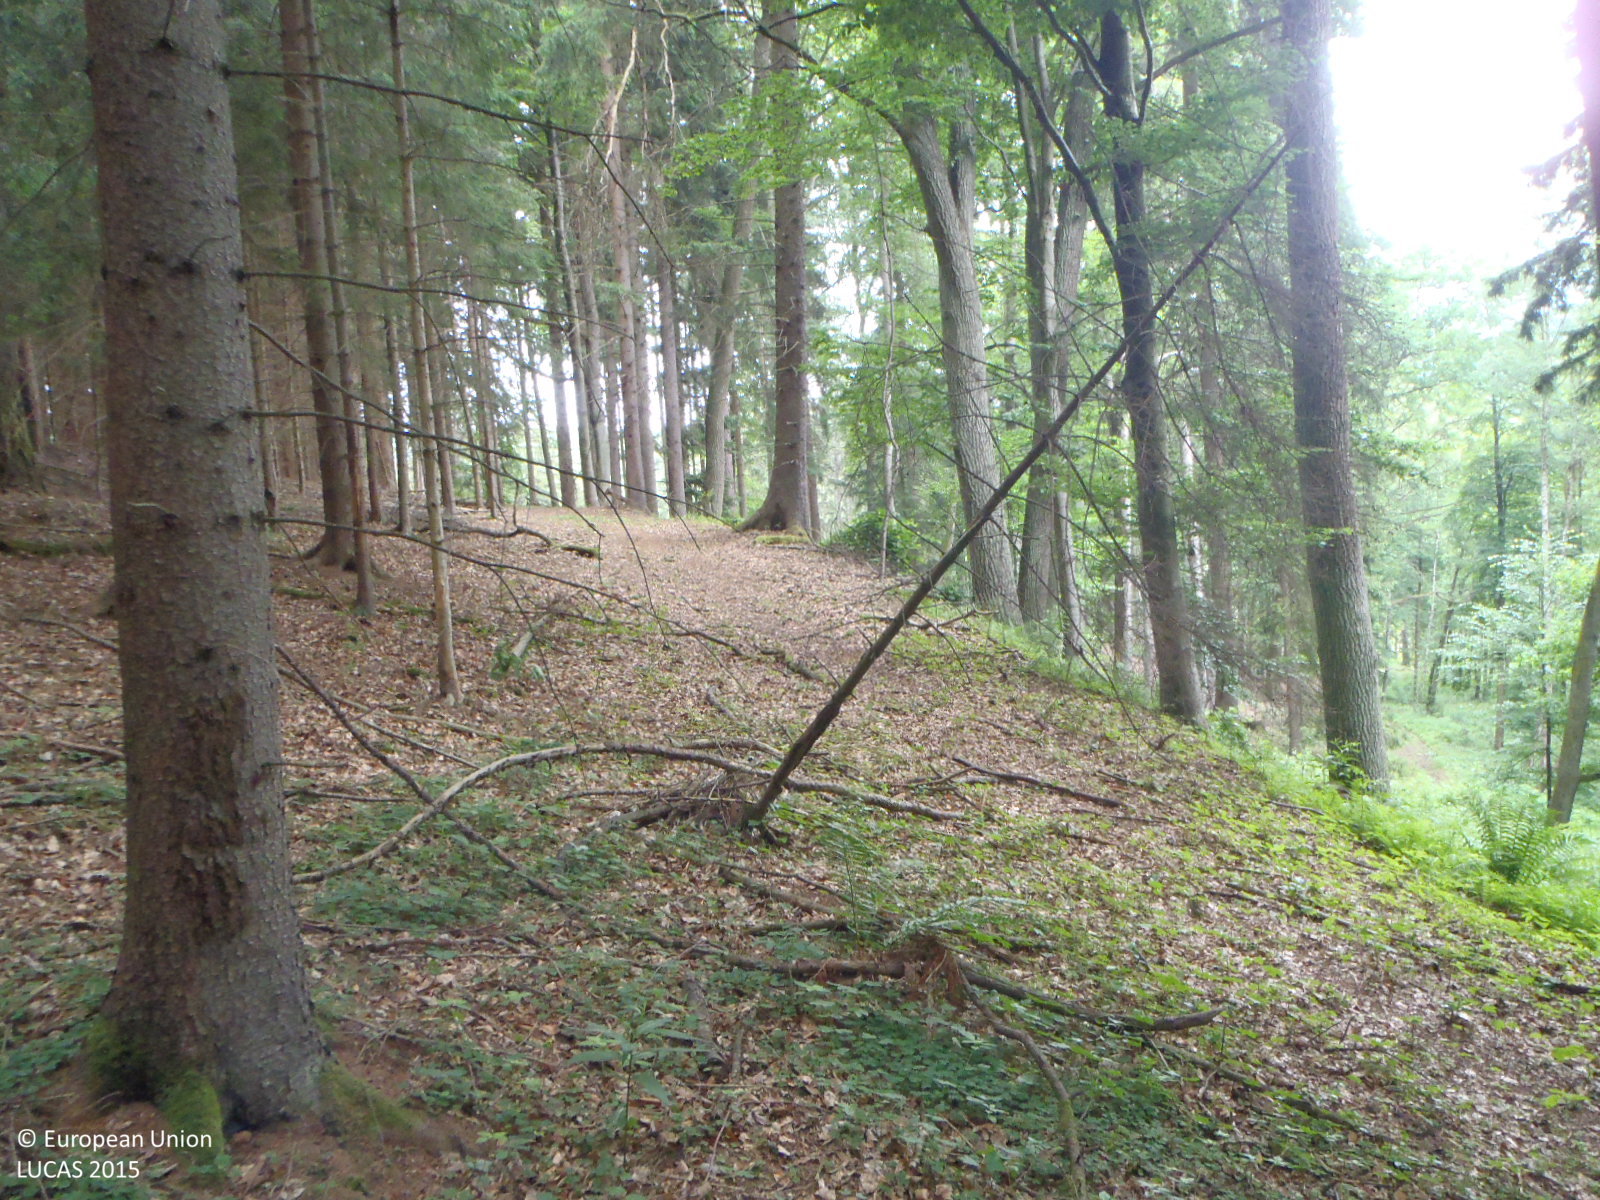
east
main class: Woodland
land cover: Spruce dominated coniferous woodland
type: hemiboreal forest and nemoral coniferous forest and mixed broadleaved-coniferous forest
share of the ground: > 75 %
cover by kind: coniferous forest trees 95 %, broadleaved forest trees 5 %
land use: Forestry
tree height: > 5 m
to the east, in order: Spruce dominated coniferous woodland; Other mixed woodland; Spruce dominated coniferous woodland; Tracks; Spruce dominated coniferous woodland; Tracks; Spruce dominated mixed woodland; Rivers and streams; Spruce dominated mixed woodland; Rivers and streams; Spruce dominated mixed woodland; Tracks; Spruce dominated mixed woodland
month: June
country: CZ
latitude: 49.9267
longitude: 17.1005
